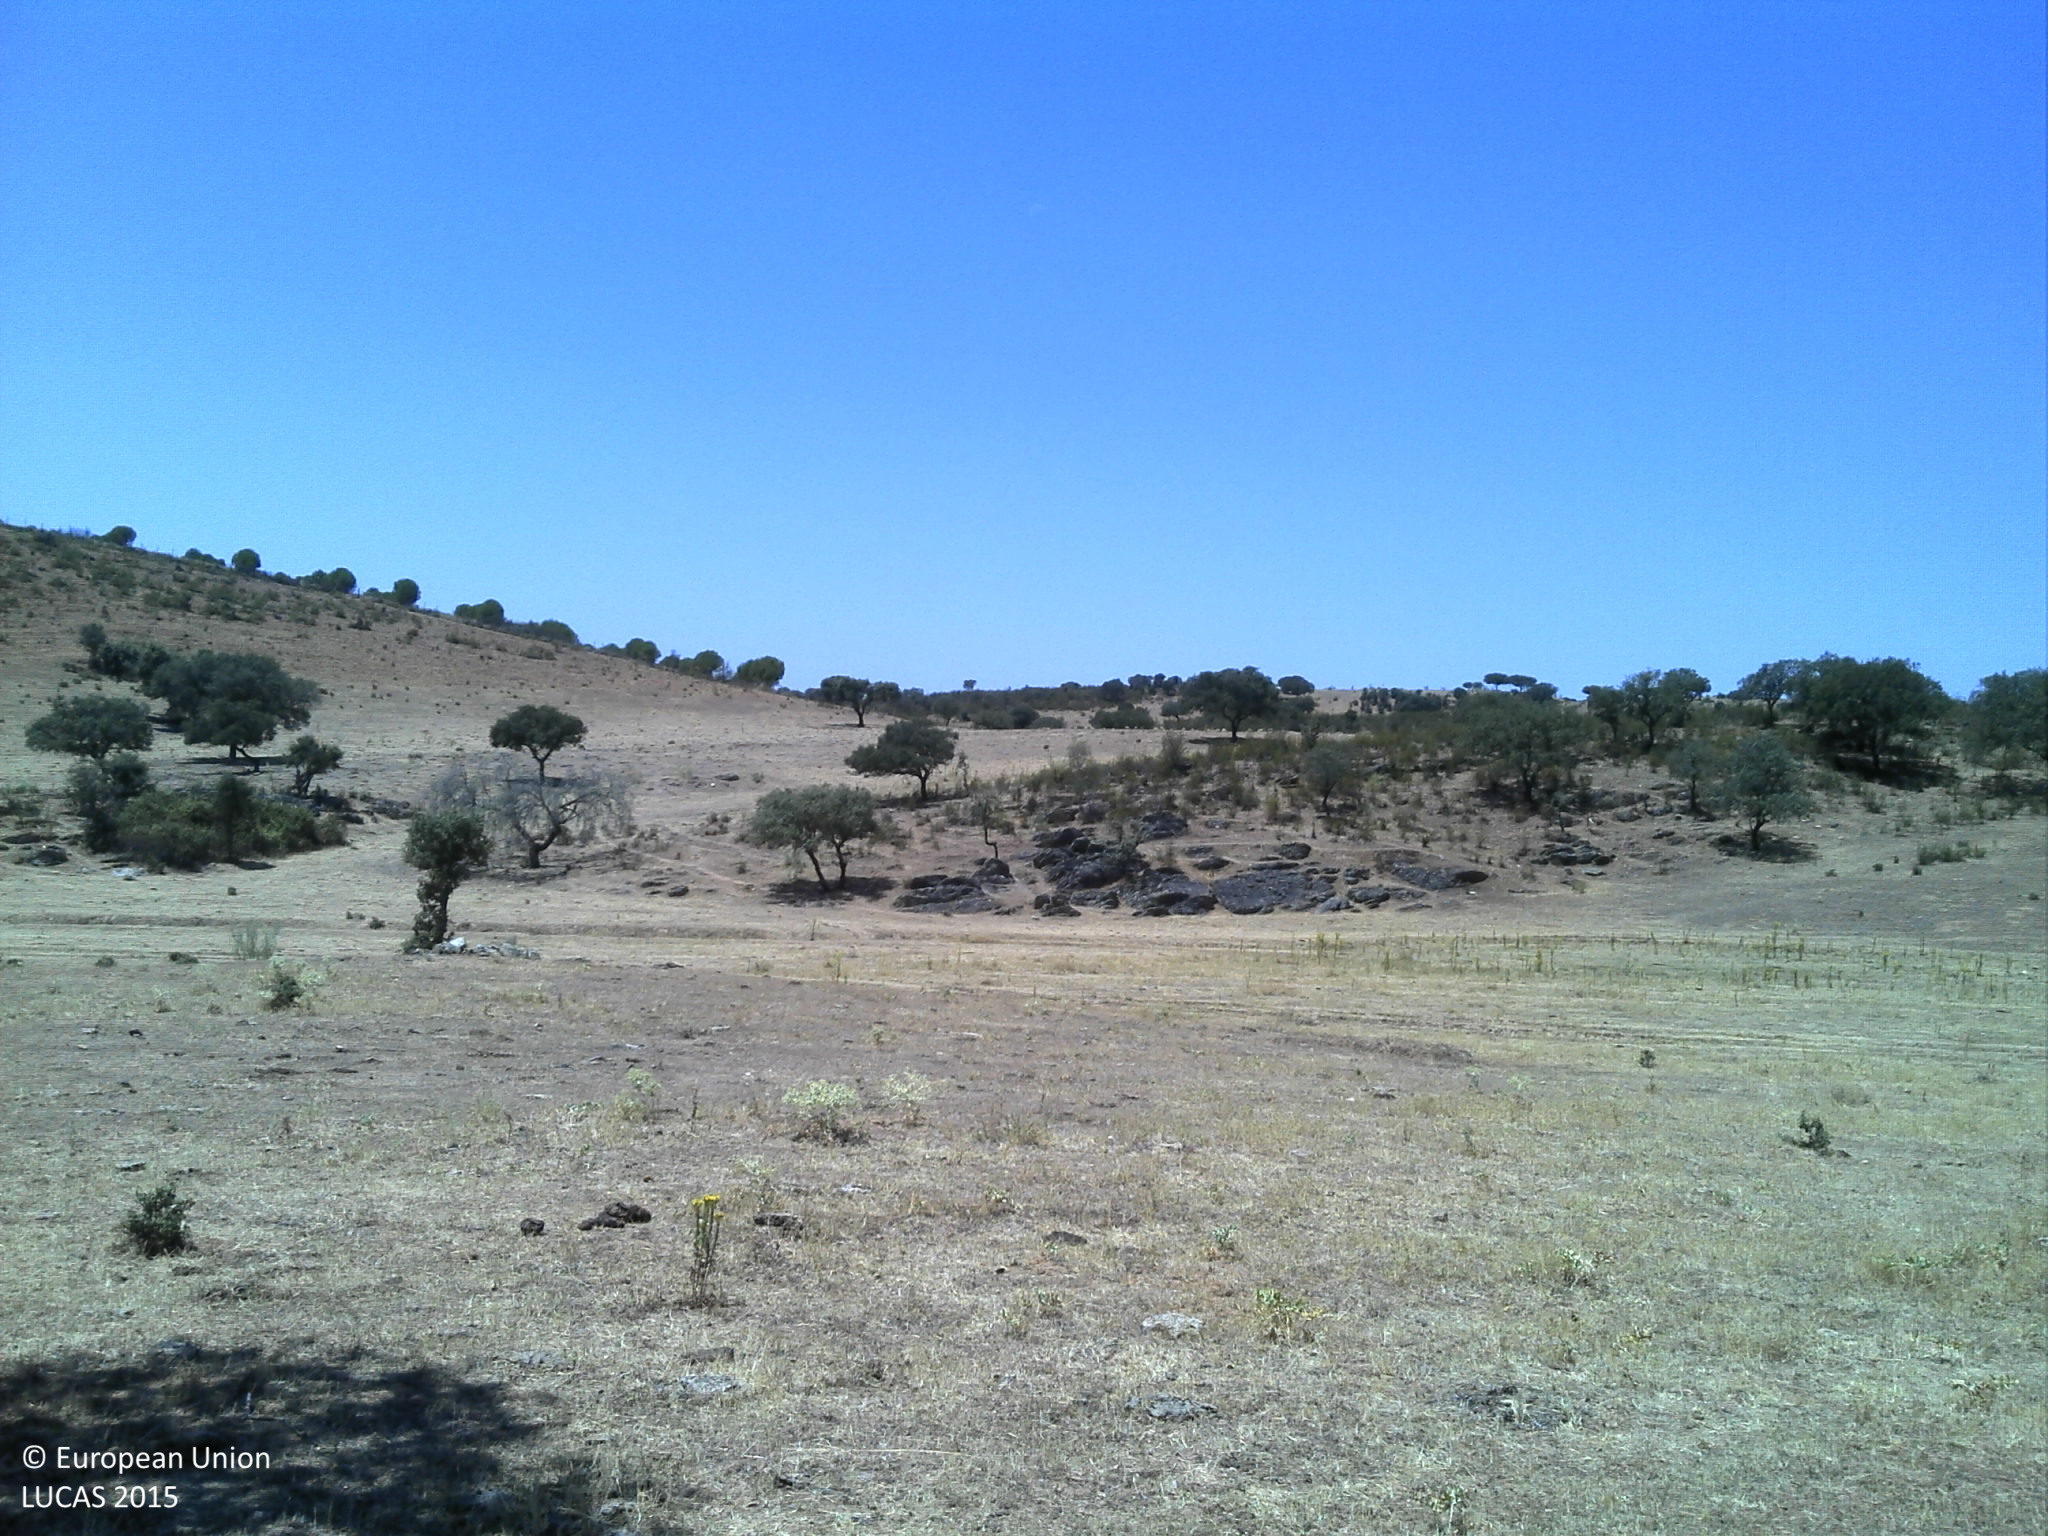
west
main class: Woodland
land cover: Broadleaved woodland
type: broadleaved evergreen forest
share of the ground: 10 - 25 %
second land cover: Grassland without tree/shrub cover
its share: 10 - 25 %
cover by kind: unconsolidated bare surface 70 %, broadleaved forest trees 15 %, herbaceous plants 15 %
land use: Forestry
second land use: Agriculture (excluding fallow land and kitchen gardens)
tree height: > 5 m
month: July
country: PT
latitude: 38.6631
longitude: -7.3941
